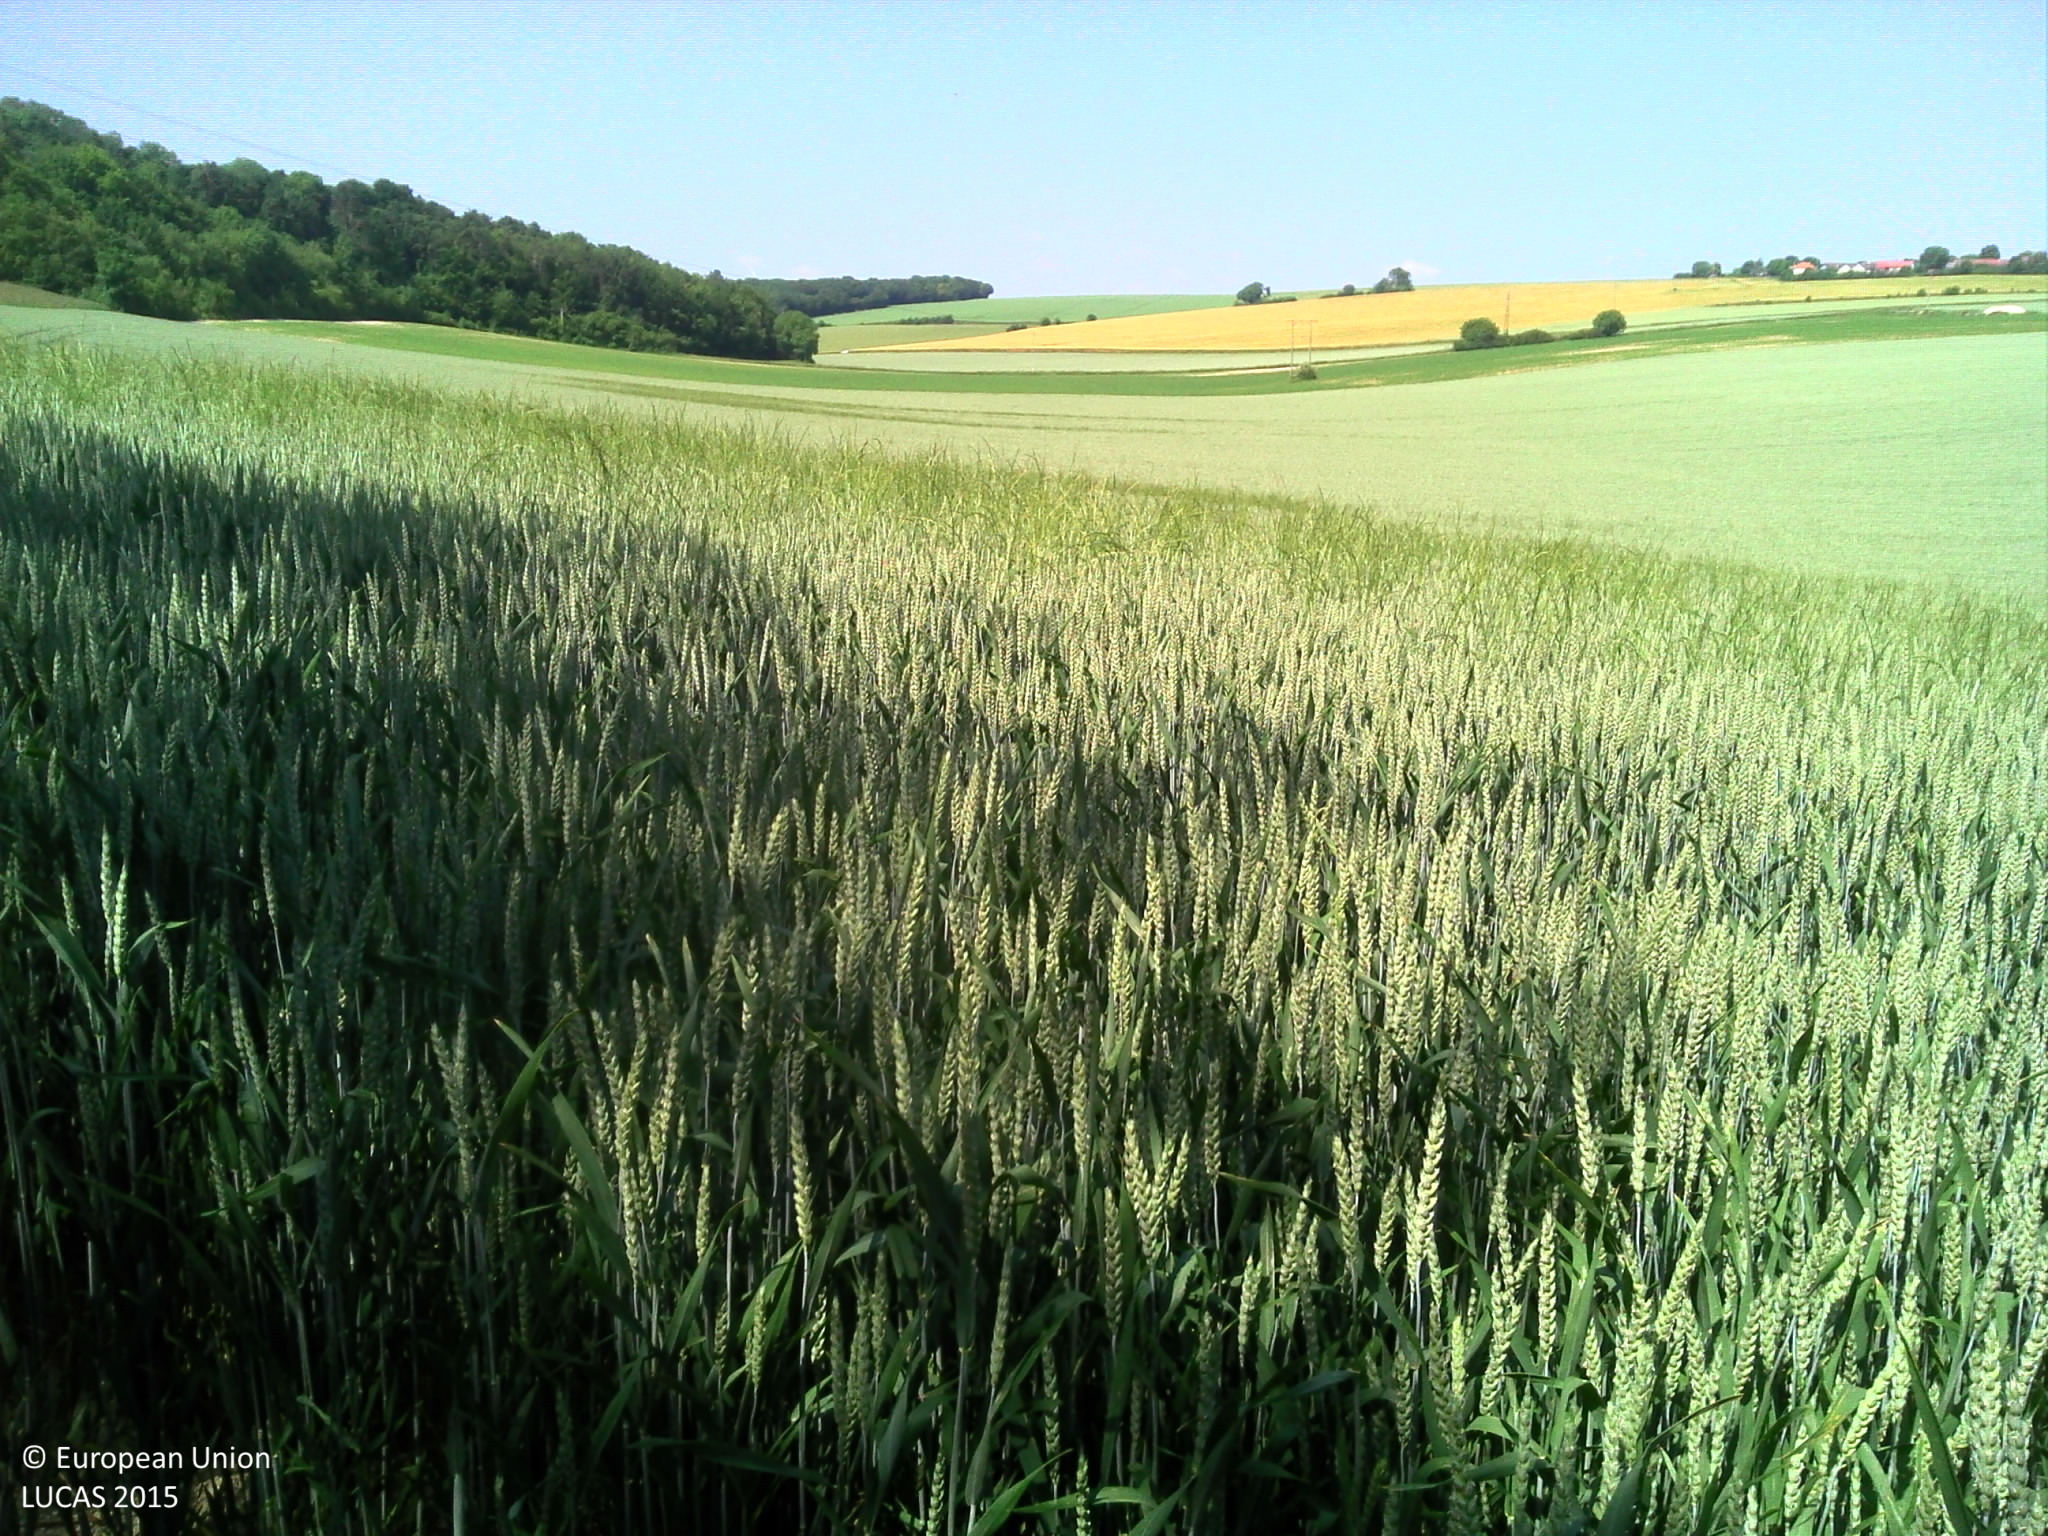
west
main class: Woodland
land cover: Broadleaved woodland
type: non-riverine alder, birch or aspen forest
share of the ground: > 75 %
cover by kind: broadleaved forest trees 80 %, shrubs 10 %, herbaceous plants 5 %, lichens and mosses 5 %
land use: Forestry
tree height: > 5 m
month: June
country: FR
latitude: 49.7193
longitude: 2.4839
